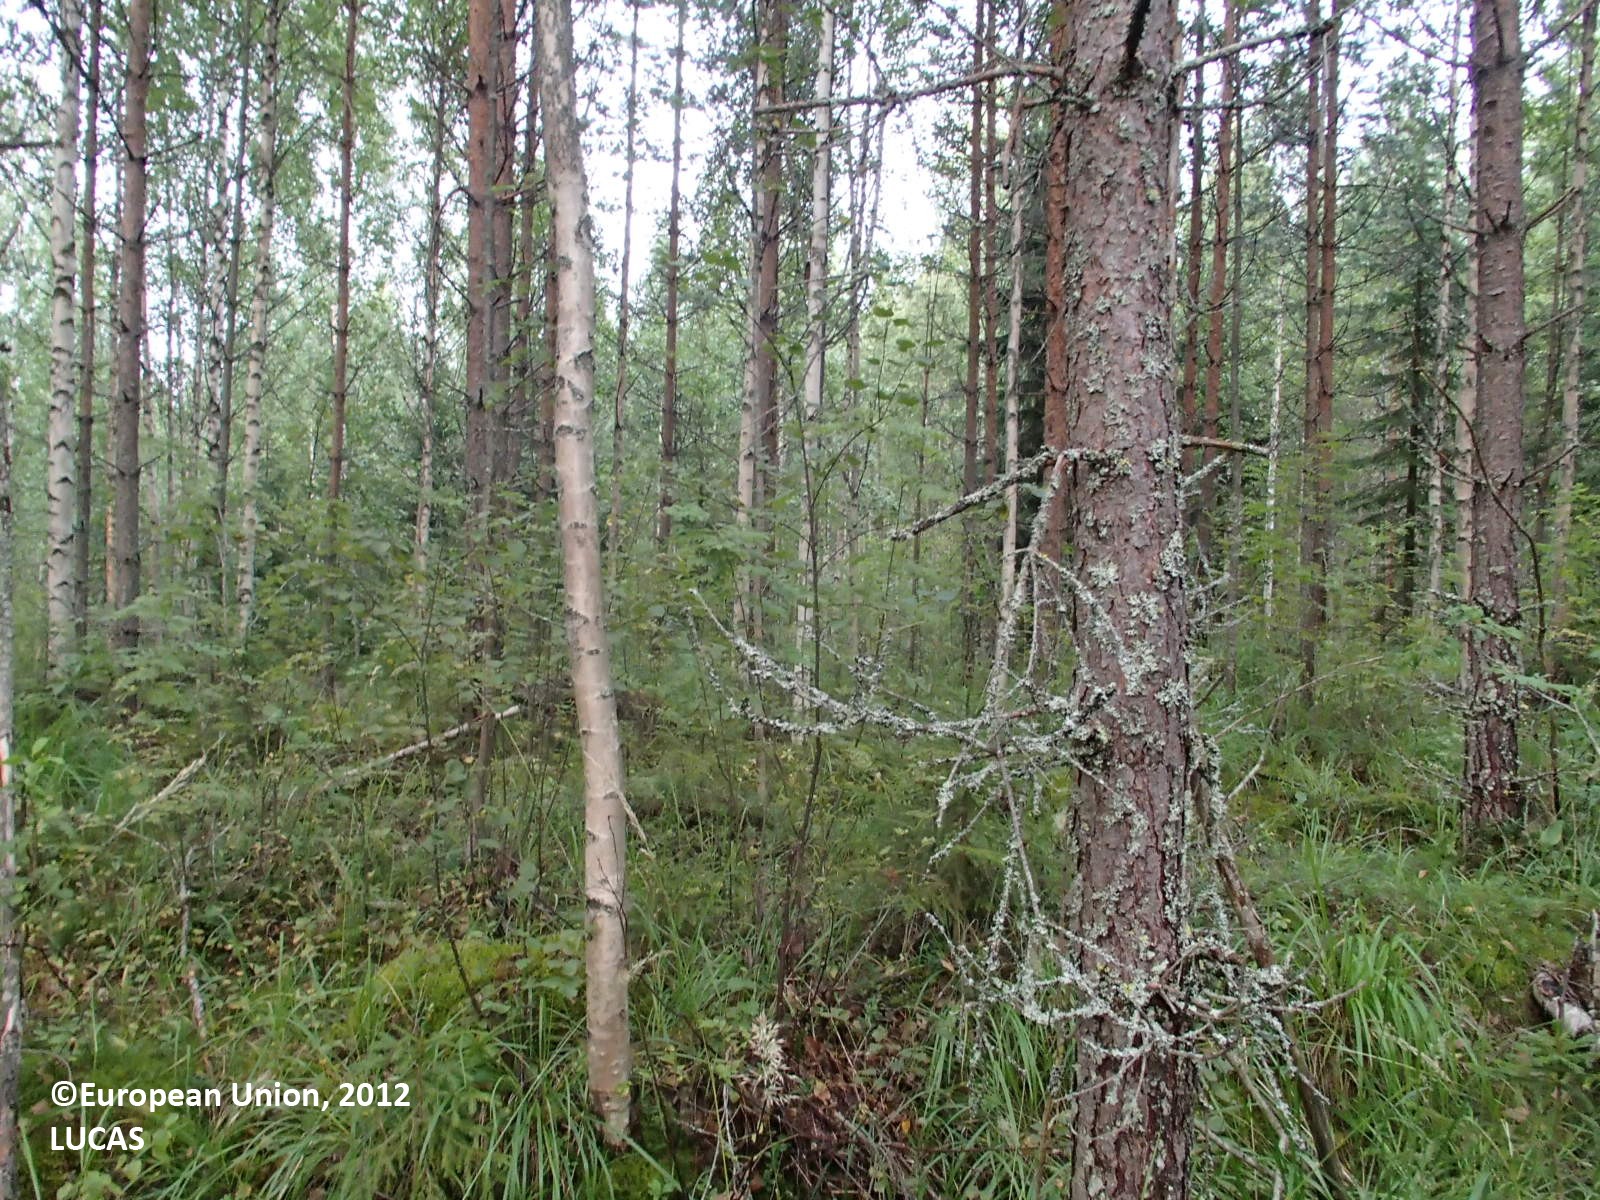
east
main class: Woodland
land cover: Pine dominated mixed woodland
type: boreal forest
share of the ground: > 75 %
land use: Forestry
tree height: > 5 m
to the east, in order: Pine dominated mixed woodland; Pine dominated coniferous woodland; Pine dominated mixed woodland
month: August
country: FI
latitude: 63.5519
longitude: 28.0641
